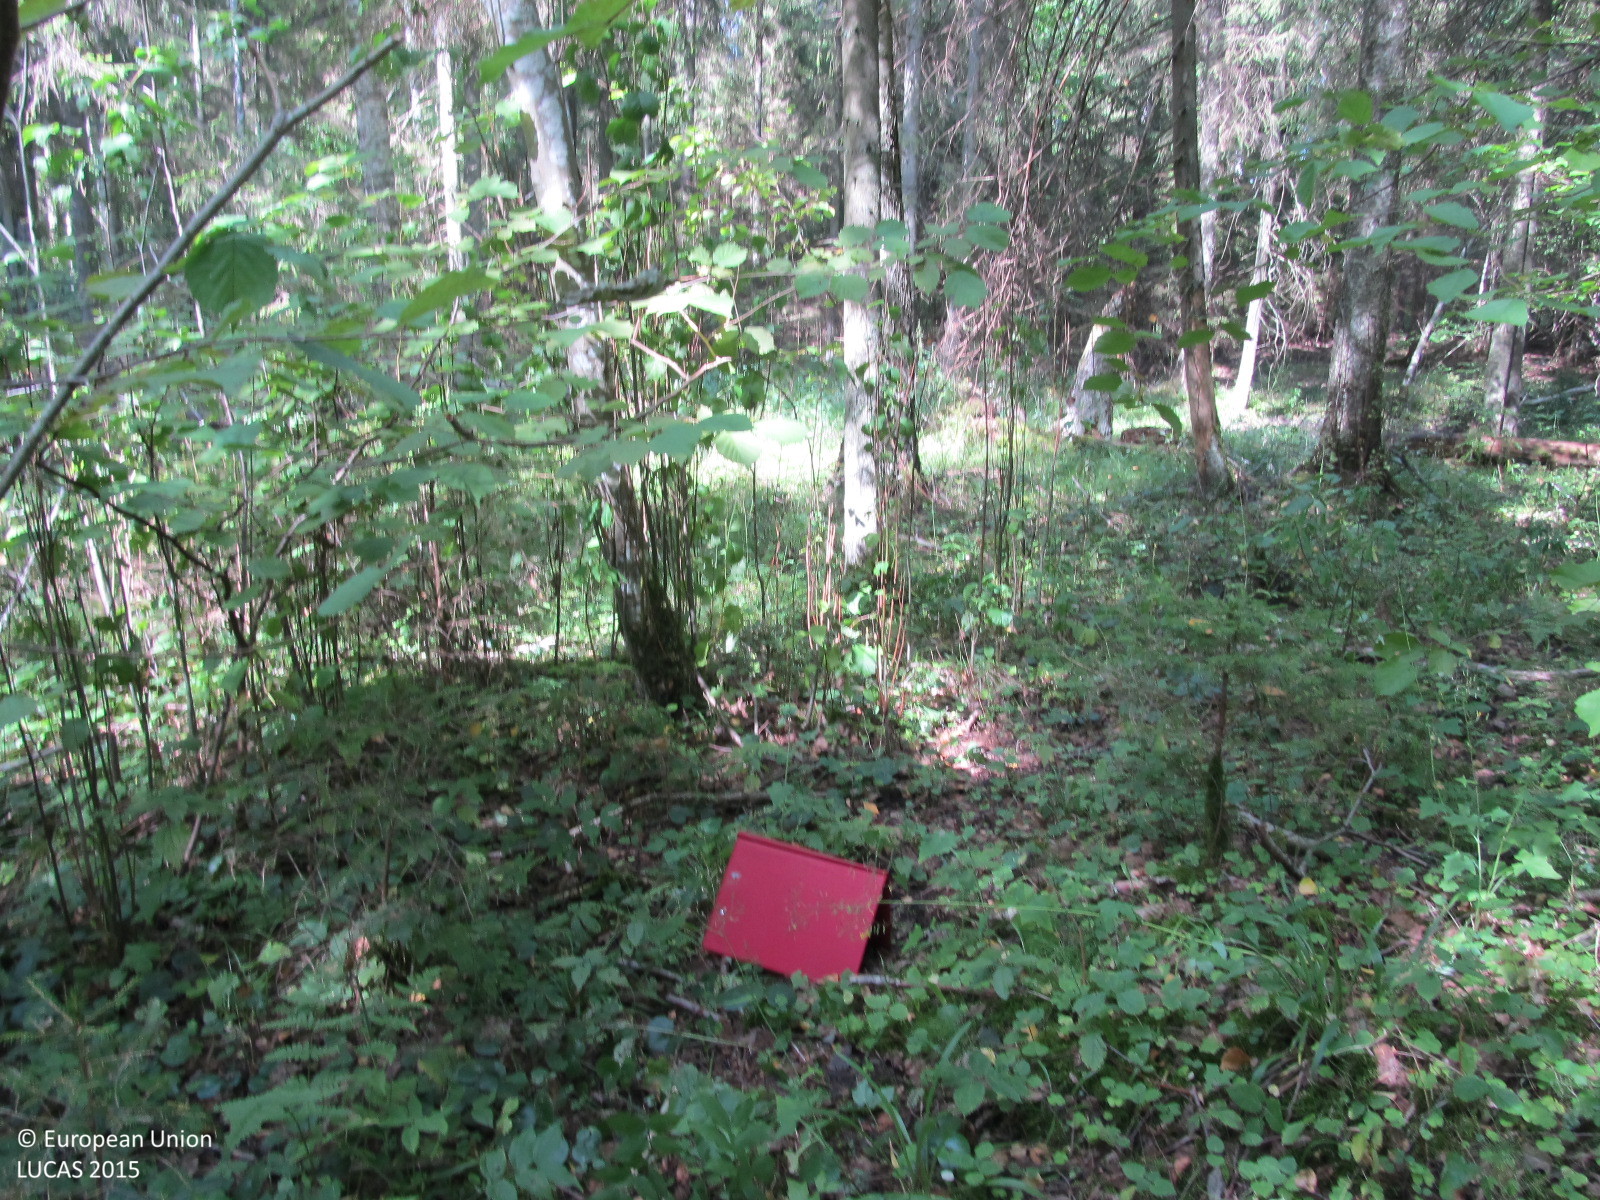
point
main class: Woodland
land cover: Spruce dominated mixed woodland
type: hemiboreal forest and nemoral coniferous forest and mixed broadleaved-coniferous forest
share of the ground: > 75 %
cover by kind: coniferous forest trees 45 %, broadleaved forest trees 40 %, herbaceous plants 10 %, shrubs 5 %
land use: Forestry
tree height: > 5 m
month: August
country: LT
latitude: 55.7782
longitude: 22.9988
